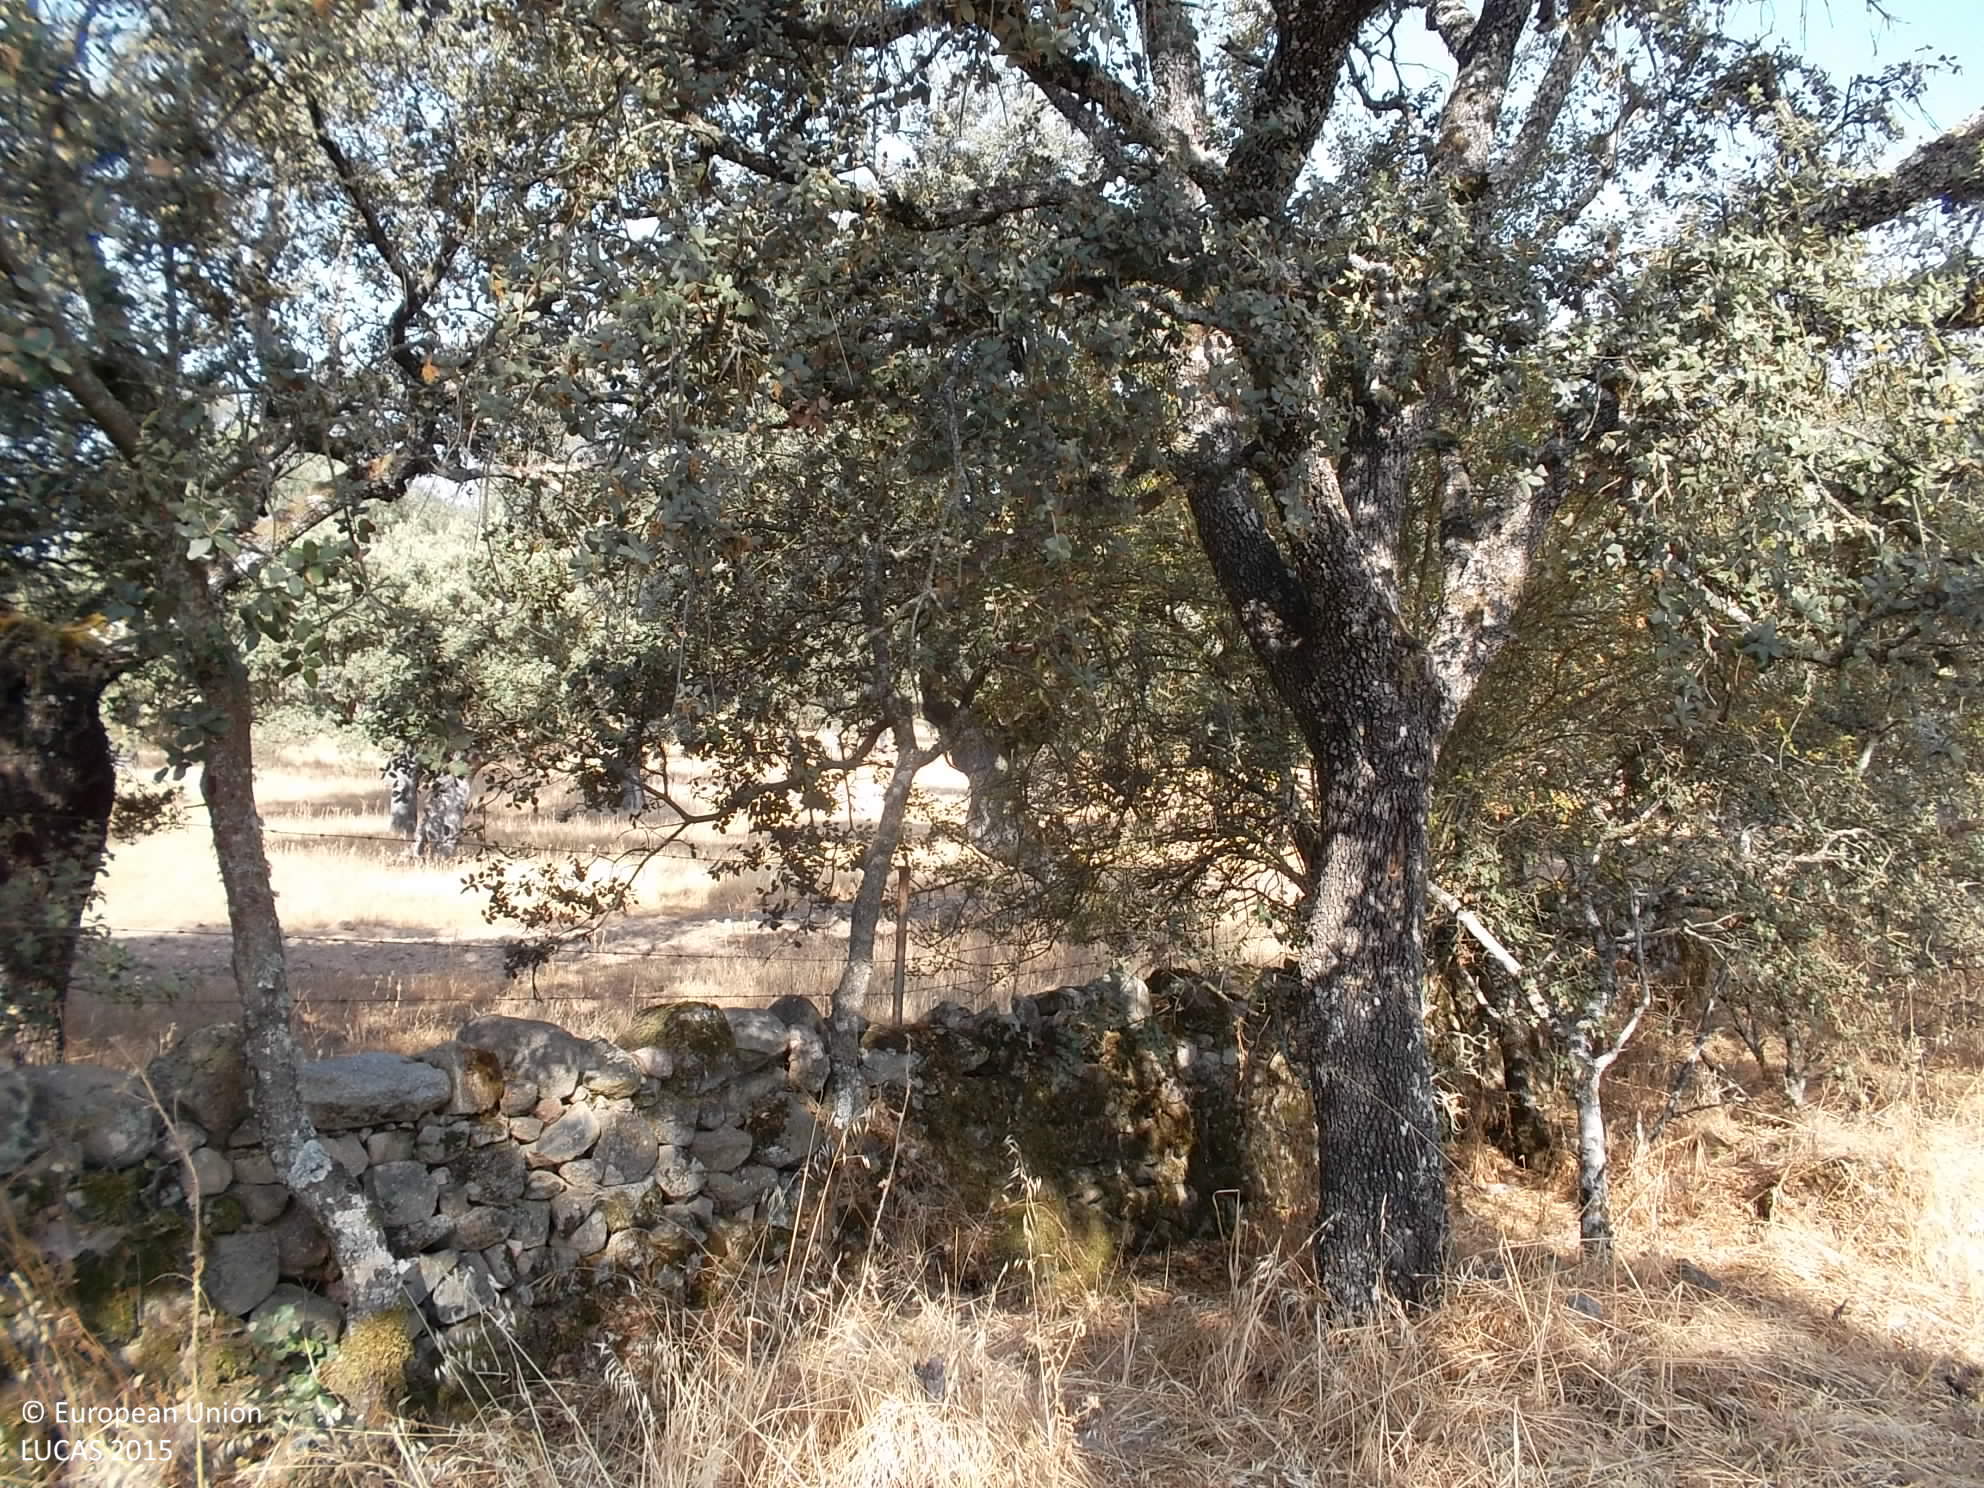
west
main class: Woodland
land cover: Broadleaved woodland
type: broadleaved evergreen forest
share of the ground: 25 - 50 %
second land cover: Grassland without tree/shrub cover
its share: > 75 %
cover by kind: herbaceous plants 70 %, broadleaved forest trees 30 %
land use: Forestry
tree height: > 5 m
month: July
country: ES
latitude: 38.2883
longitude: -4.7114
